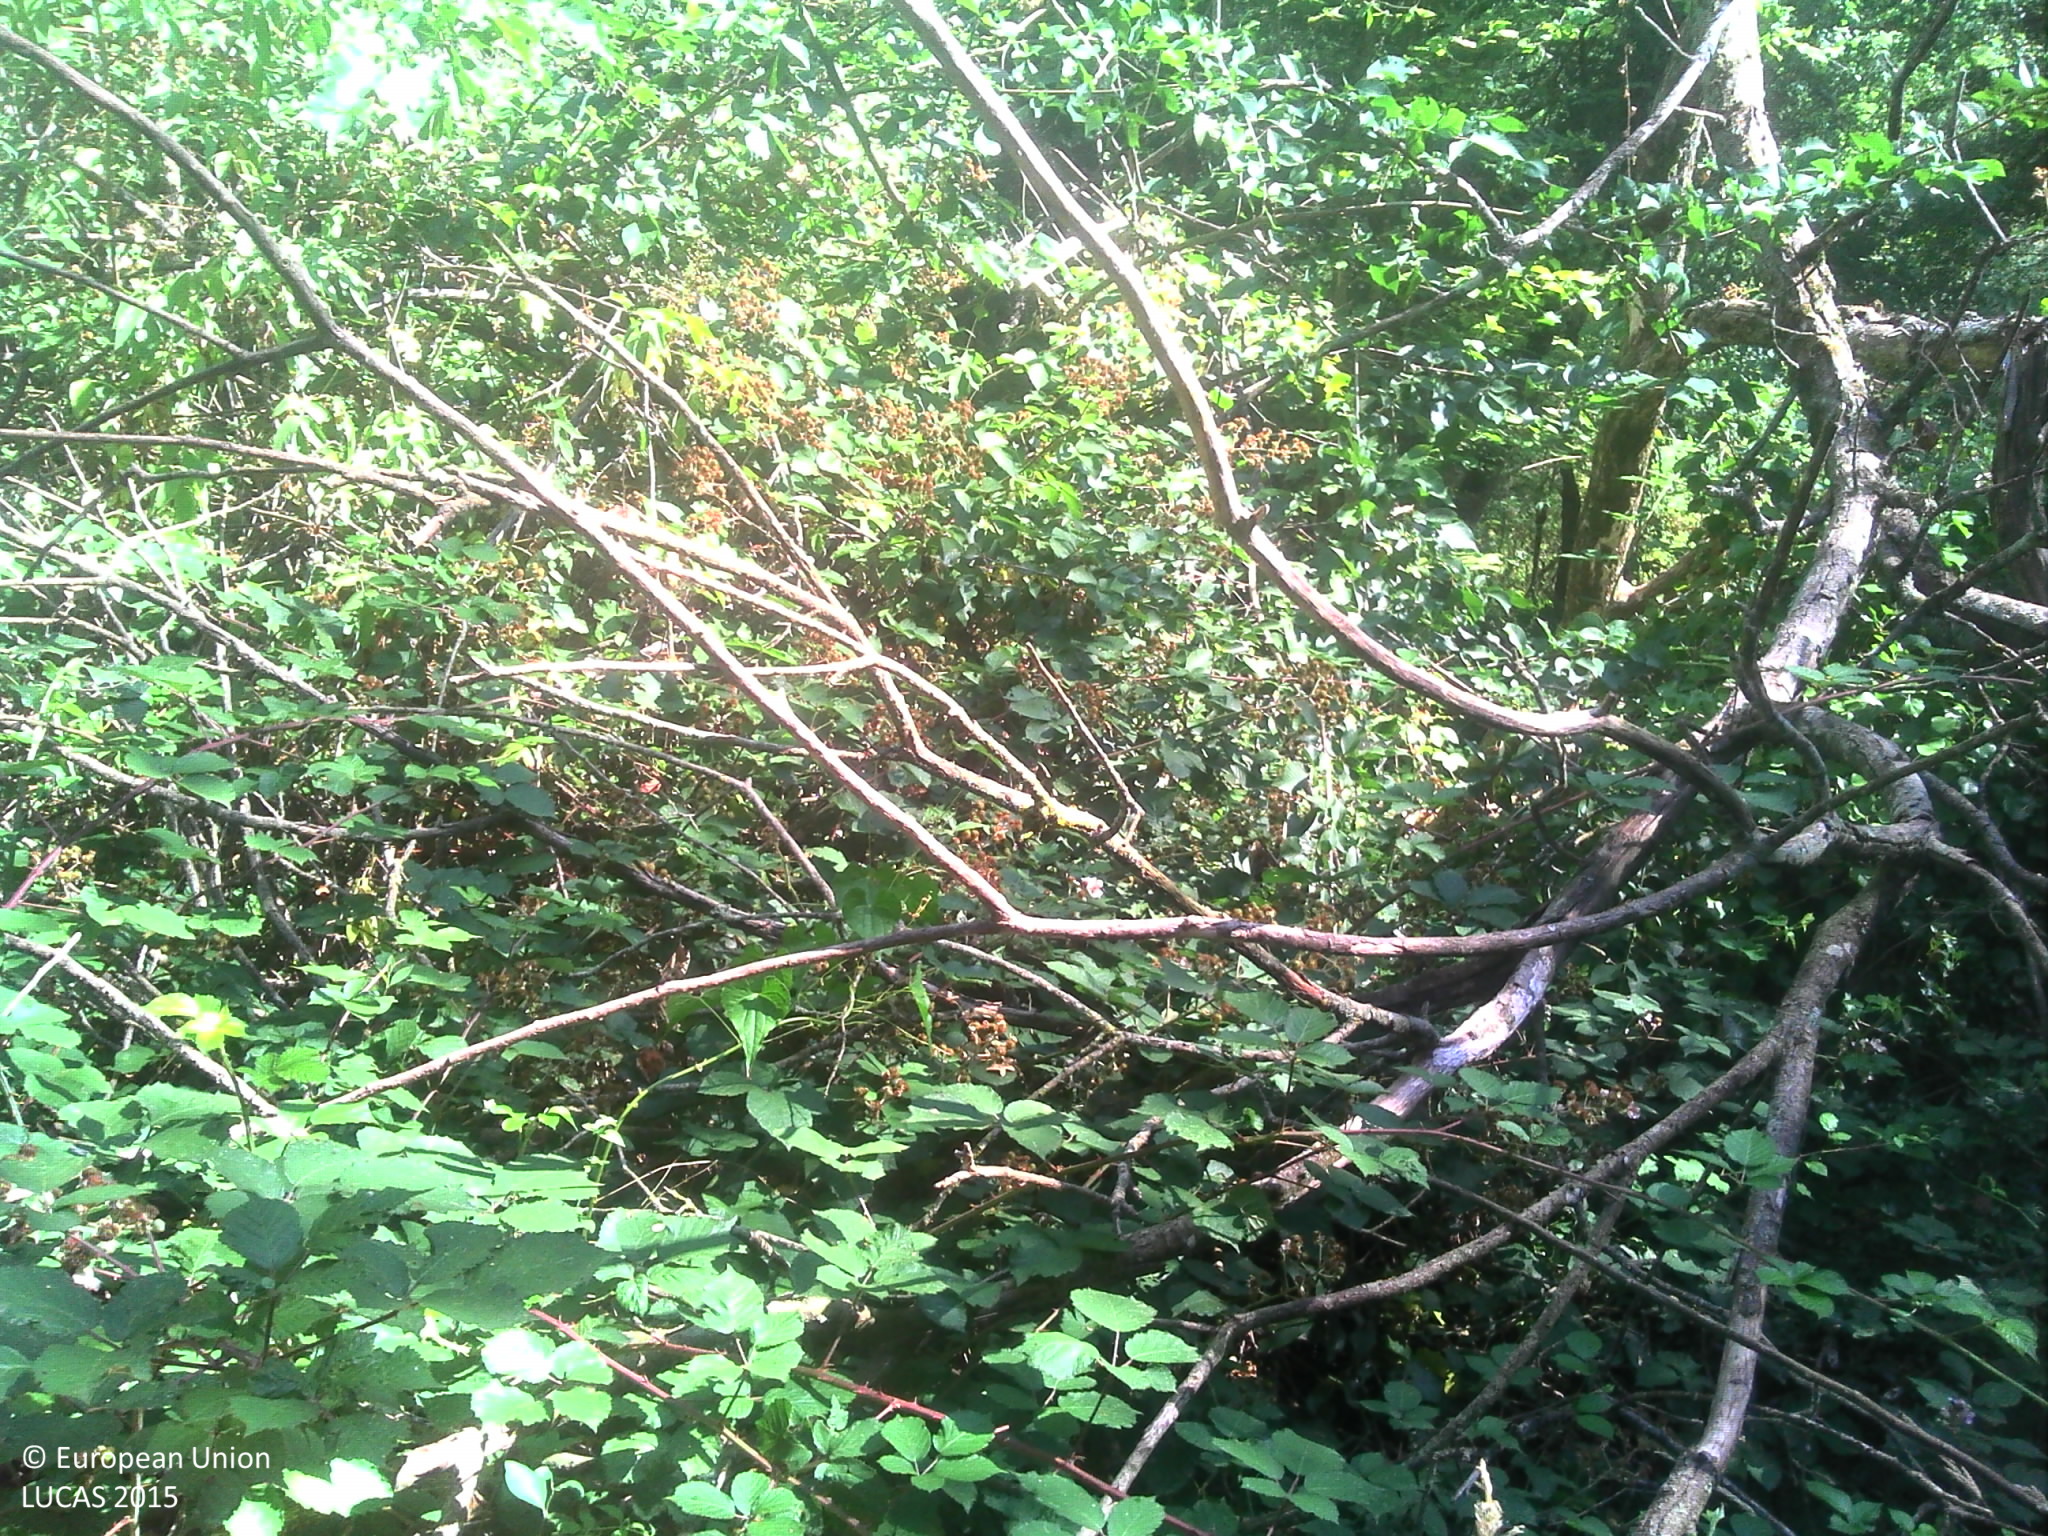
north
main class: Woodland
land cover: Broadleaved woodland
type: mesophytic deciduous forest
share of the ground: > 75 %
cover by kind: herbaceous plants 50 %, broadleaved forest trees 40 %, unconsolidated bare surface 10 %
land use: Forestry
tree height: > 5 m
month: July
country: FR
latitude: 47.9541
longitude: 0.8878
